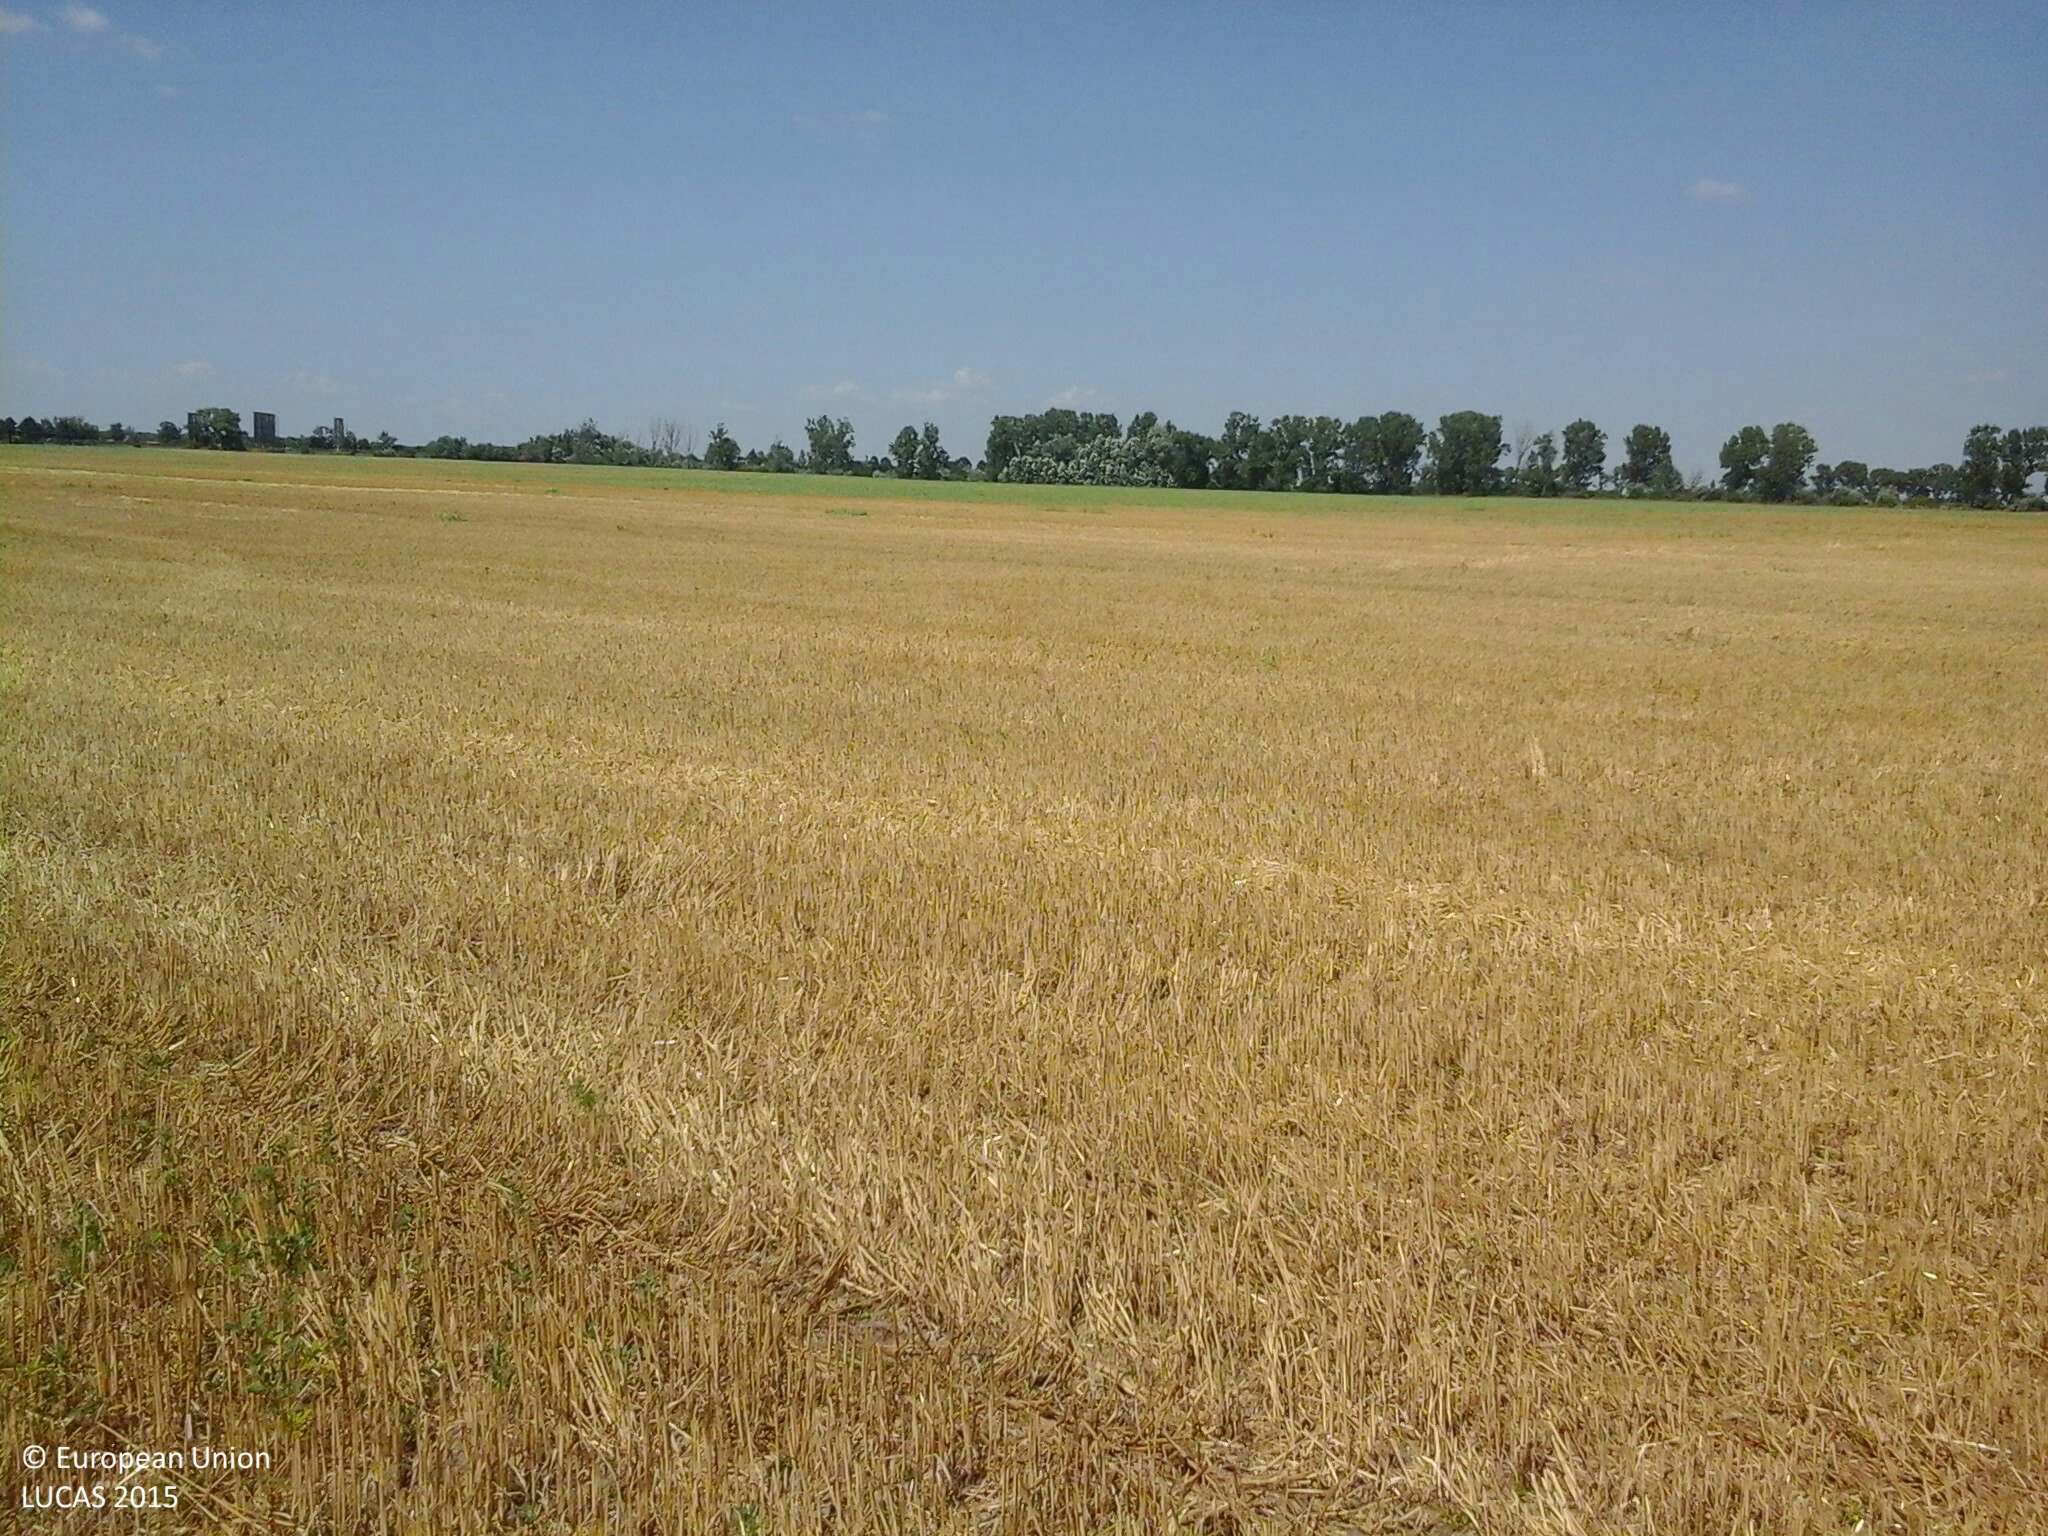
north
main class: Cropland
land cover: Common wheat
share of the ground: 25 - 50 %
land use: Agriculture (excluding fallow land and kitchen gardens)
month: July
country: HU
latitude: 47.0406
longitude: 18.3158
